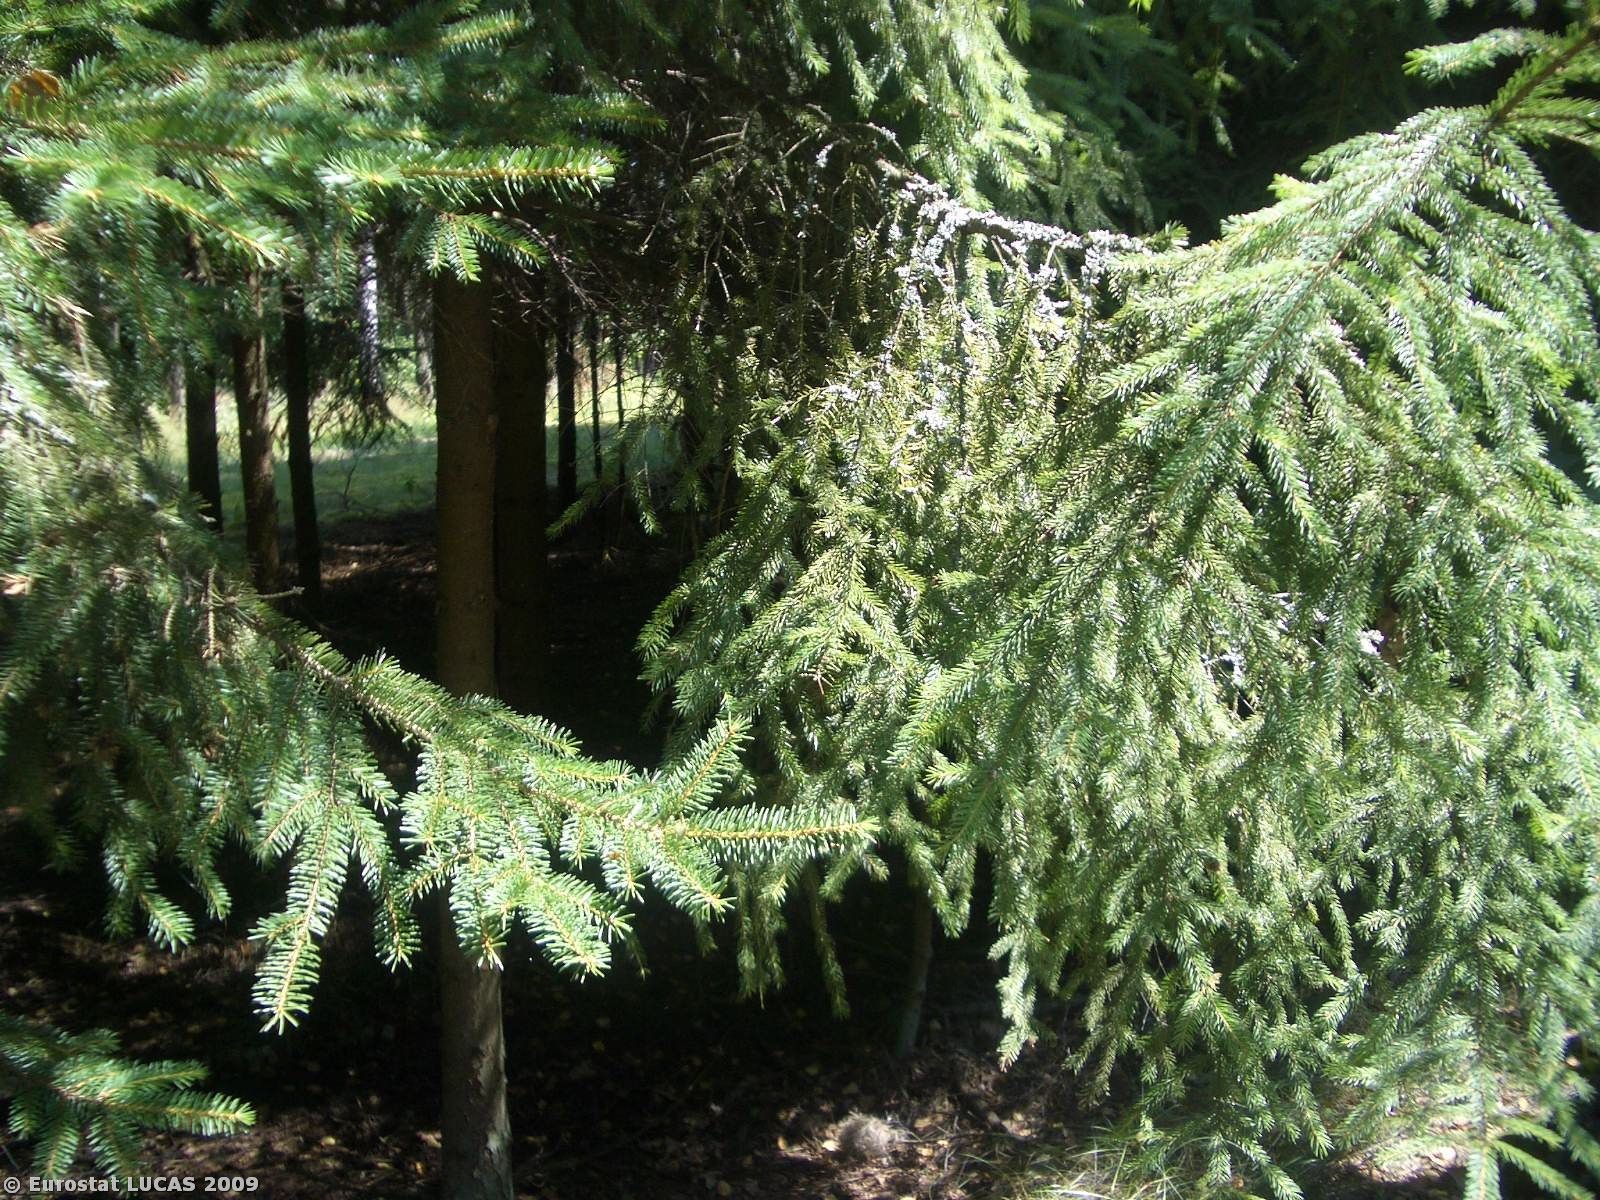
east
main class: Woodland
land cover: Mixed woodland
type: hemiboreal forest and nemoral coniferous forest and mixed broadleaved-coniferous forest
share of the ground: > 75 %
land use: Forestry
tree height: > 5 m
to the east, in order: Mixed woodland; Ditches and canals; Mixed woodland
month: July
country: PL
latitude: 51.5177
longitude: 23.1193
